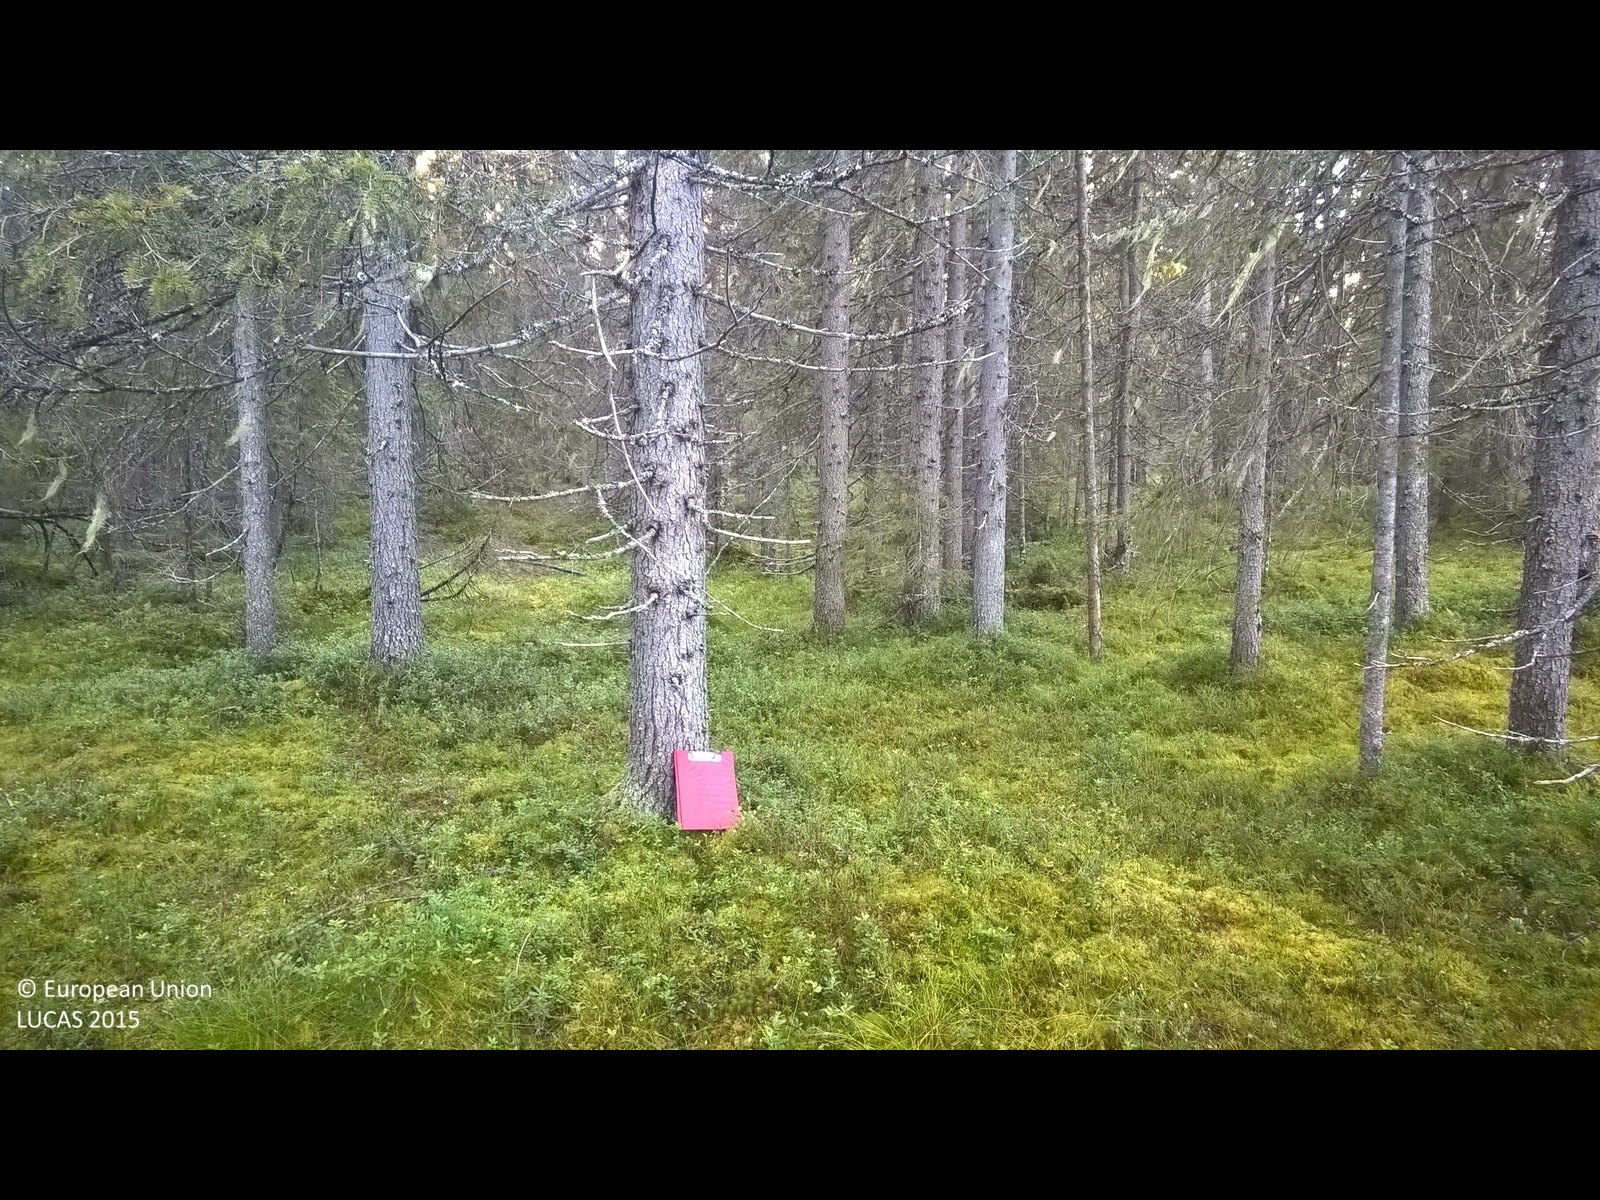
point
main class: Woodland
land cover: Spruce dominated coniferous woodland
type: boreal forest
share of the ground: > 75 %
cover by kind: coniferous forest trees 75 %, shrubs 20 %, herbaceous plants 5 %
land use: Forestry
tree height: > 5 m
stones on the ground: < 10 %
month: October
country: SE
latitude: 65.3684
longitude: 18.5410
